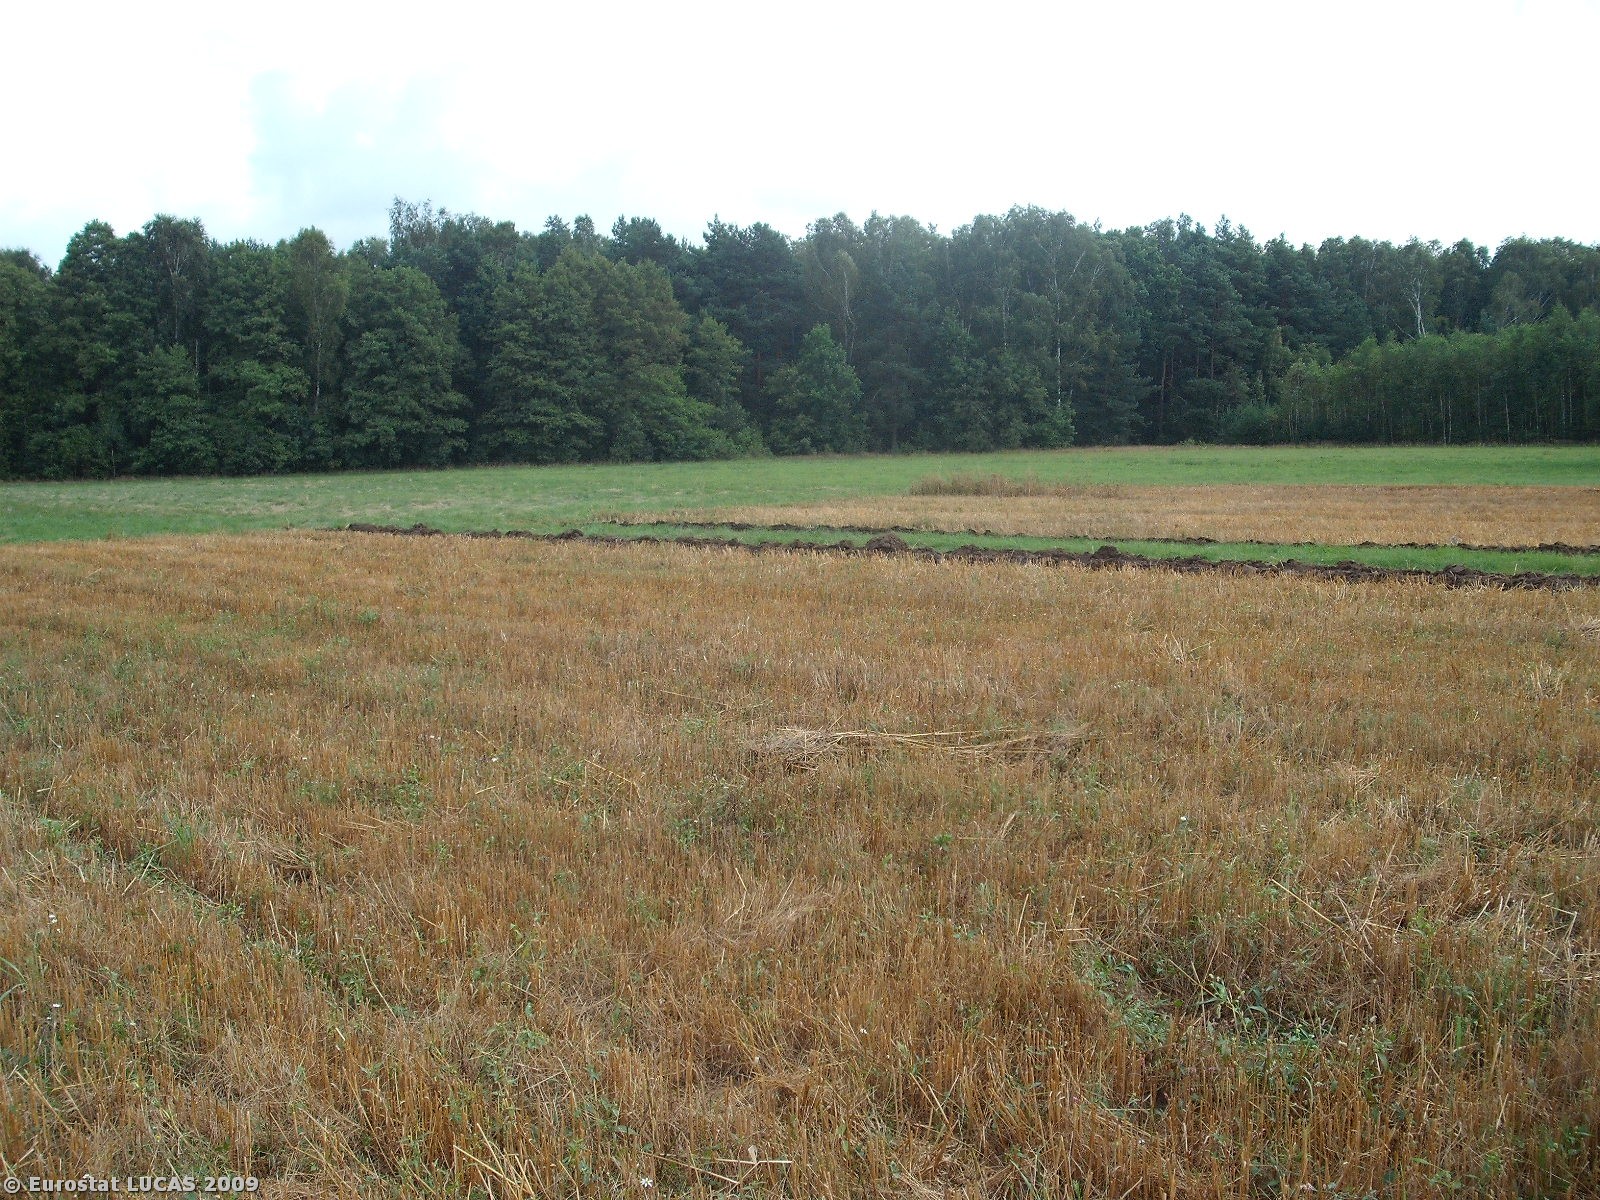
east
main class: Cropland
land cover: Rye
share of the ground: < 10 %
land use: Agriculture (excluding fallow land and kitchen gardens)
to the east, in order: Rye; Tracks; Oats; Grassland without tree/shrub cover; Mixed woodland; Tracks; Coniferous woodland
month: August
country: PL
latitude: 52.4190
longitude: 21.6544
